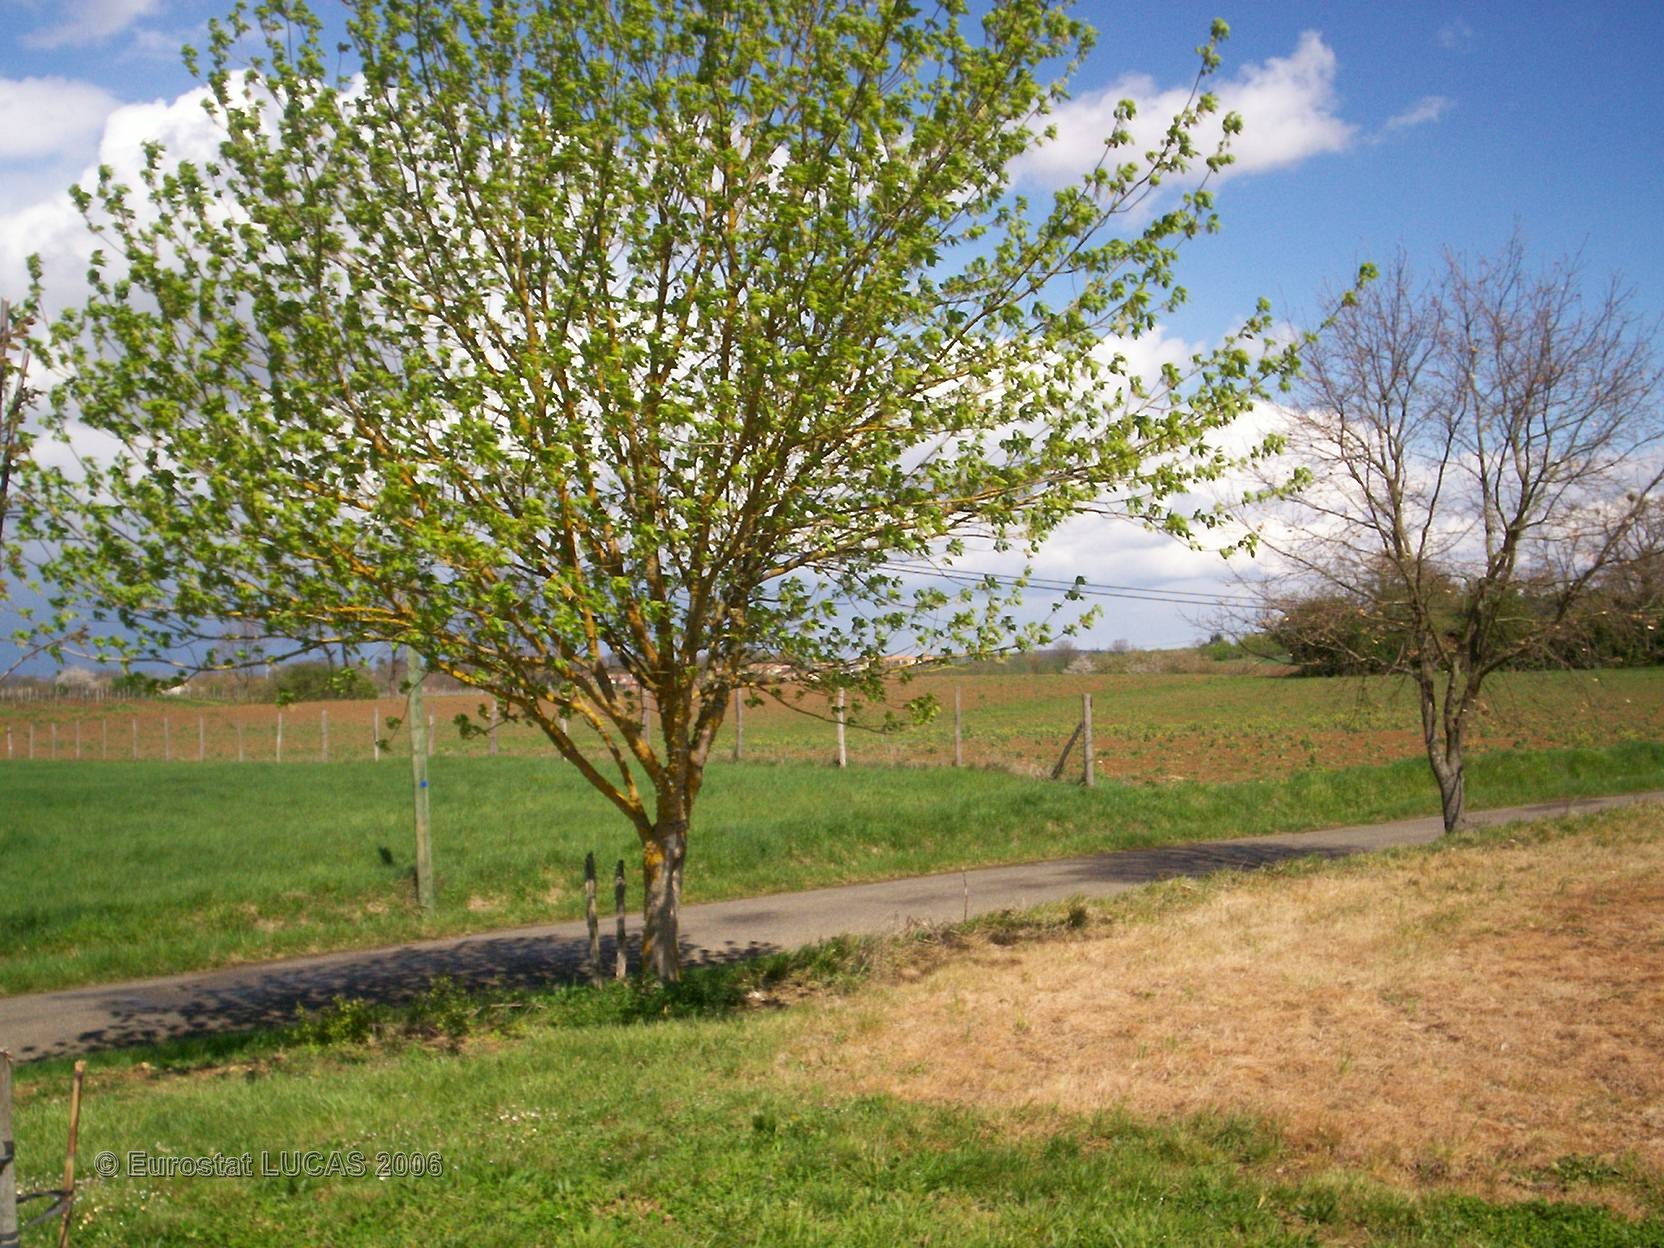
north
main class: Cropland
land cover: Floriculture and ornamental plants
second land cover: Grassland with sparse tree/shrub cover
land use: Agriculture (excluding fallow land and kitchen gardens)
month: April
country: FR
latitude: 43.9259
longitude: 0.2411
